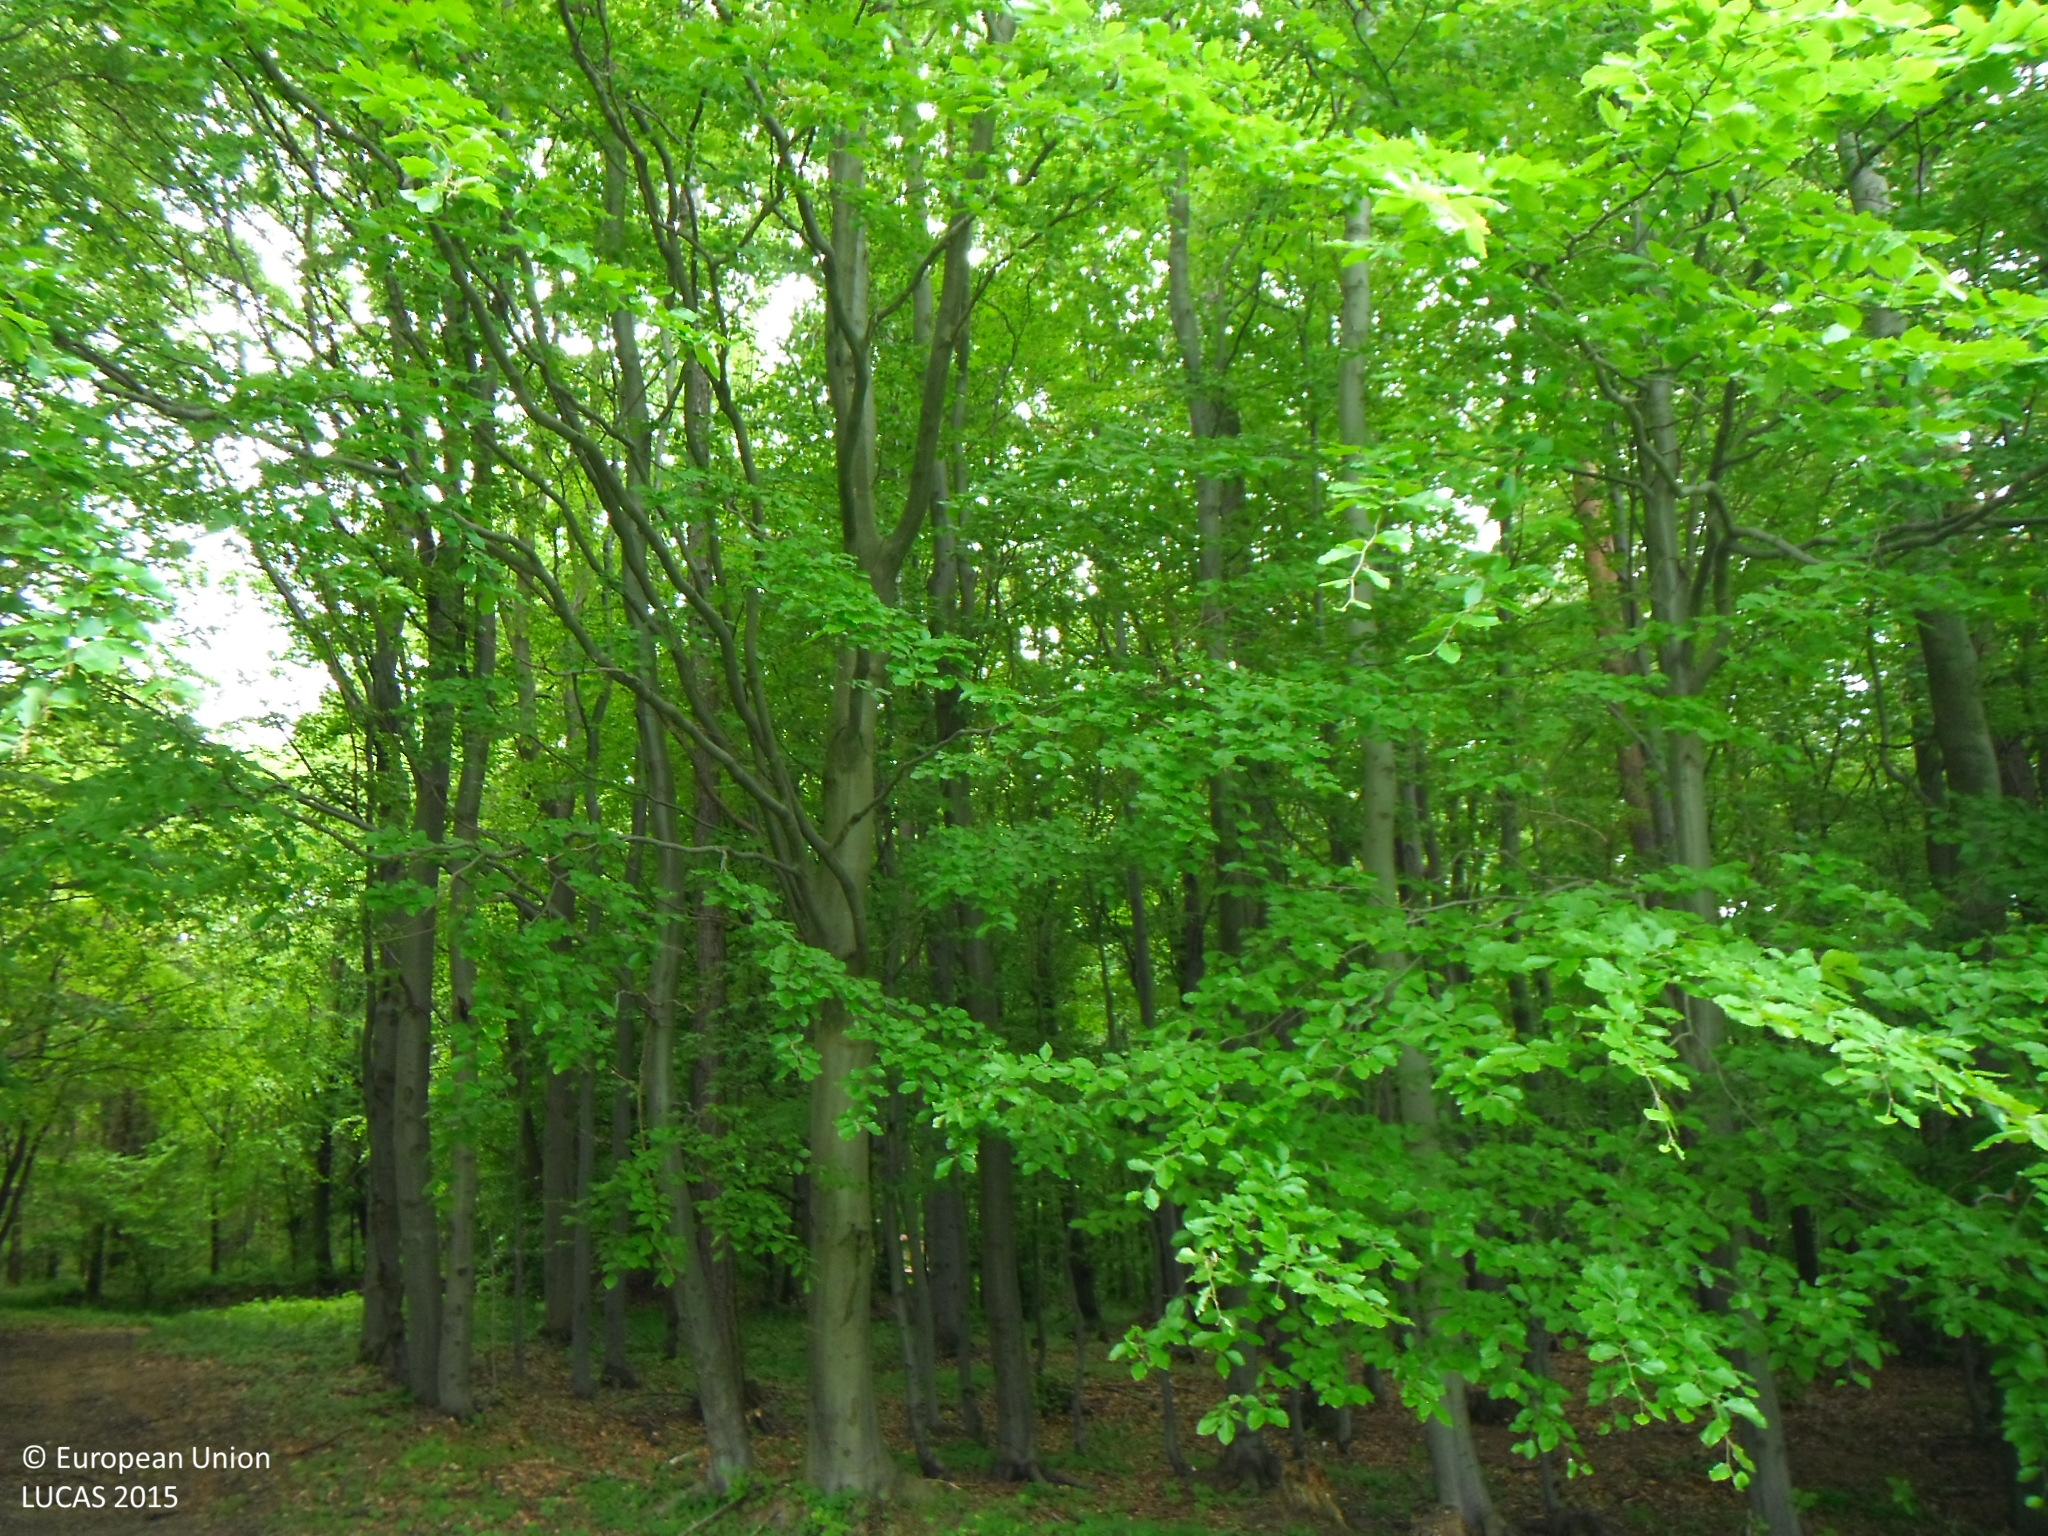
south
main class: Grassland
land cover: Grassland without tree/shrub cover
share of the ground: > 75 %
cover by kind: herbaceous plants 100 %
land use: Agriculture (excluding fallow land and kitchen gardens)
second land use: Amenities, museums, leisure
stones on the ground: < 10 %
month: May
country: SK
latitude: 49.1043
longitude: 21.0141
